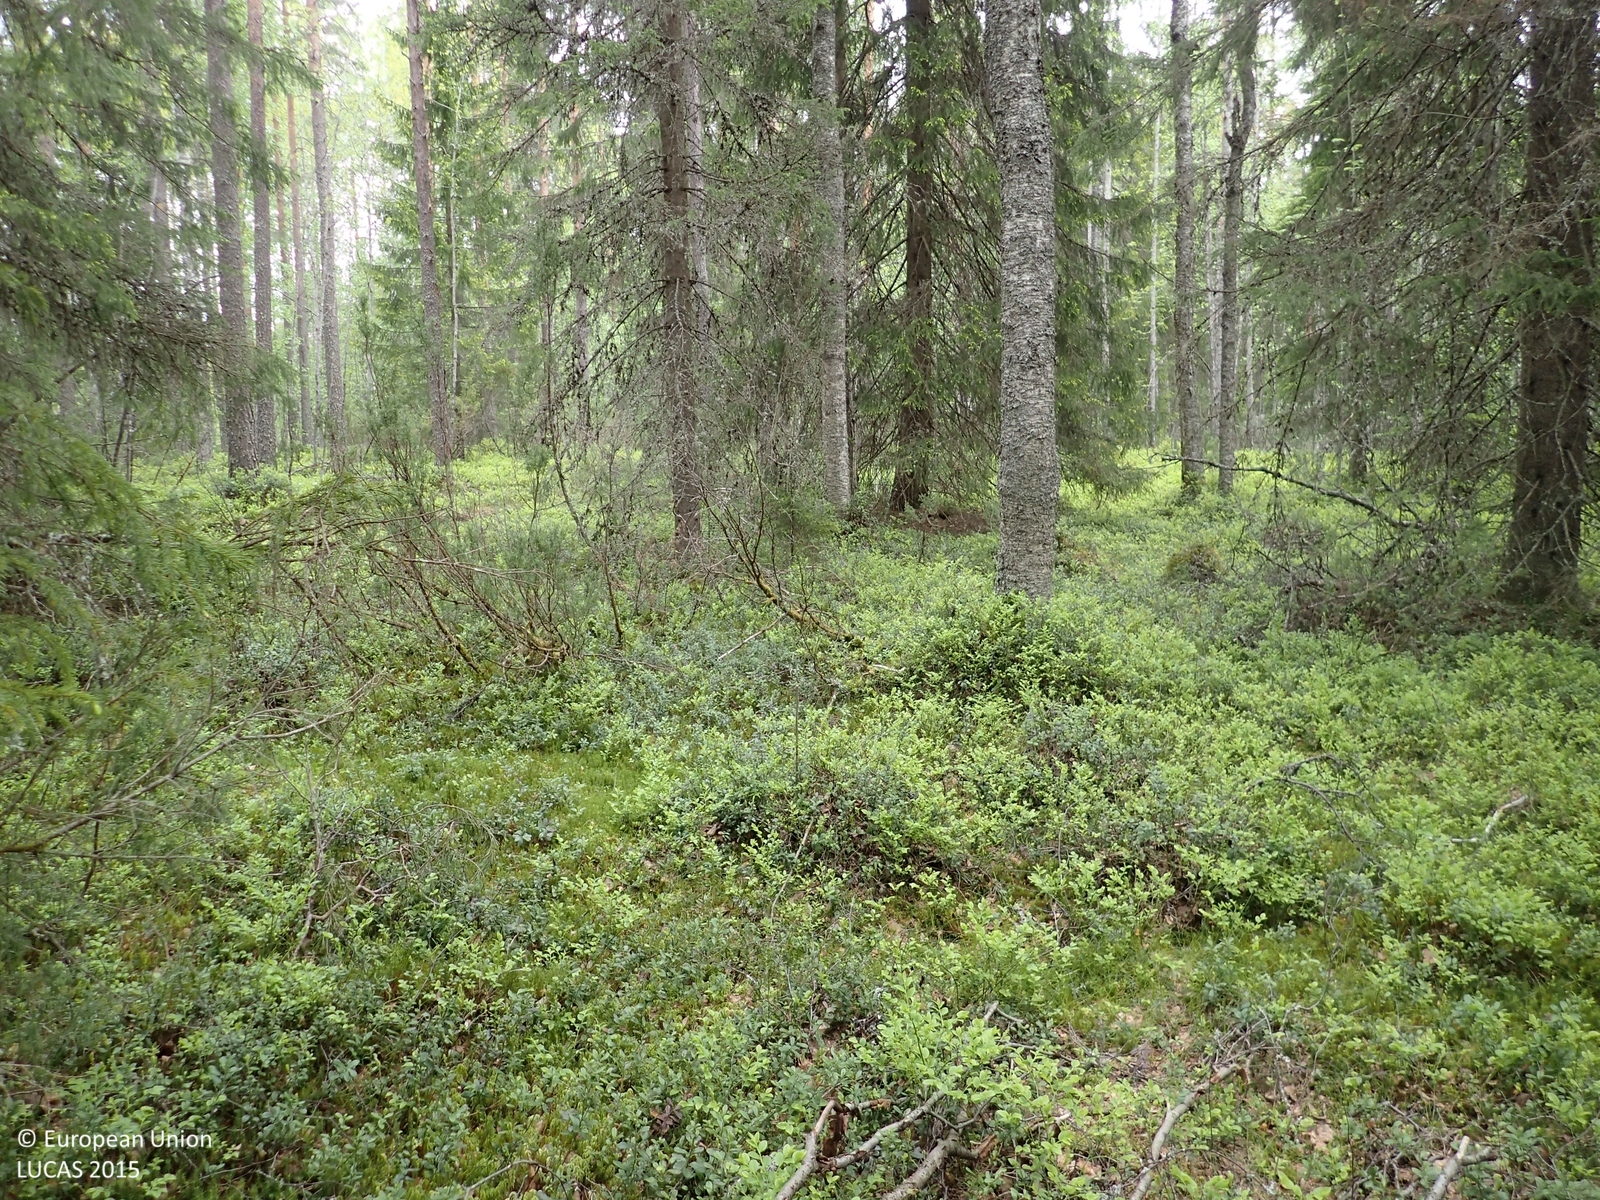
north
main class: Woodland
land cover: Spruce dominated mixed woodland
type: boreal forest
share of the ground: > 75 %
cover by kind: coniferous forest trees 65 %, broadleaved forest trees 25 %, shrubs 10 %
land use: Forestry
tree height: > 5 m
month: June
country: FI
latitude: 62.3023
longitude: 22.5744
